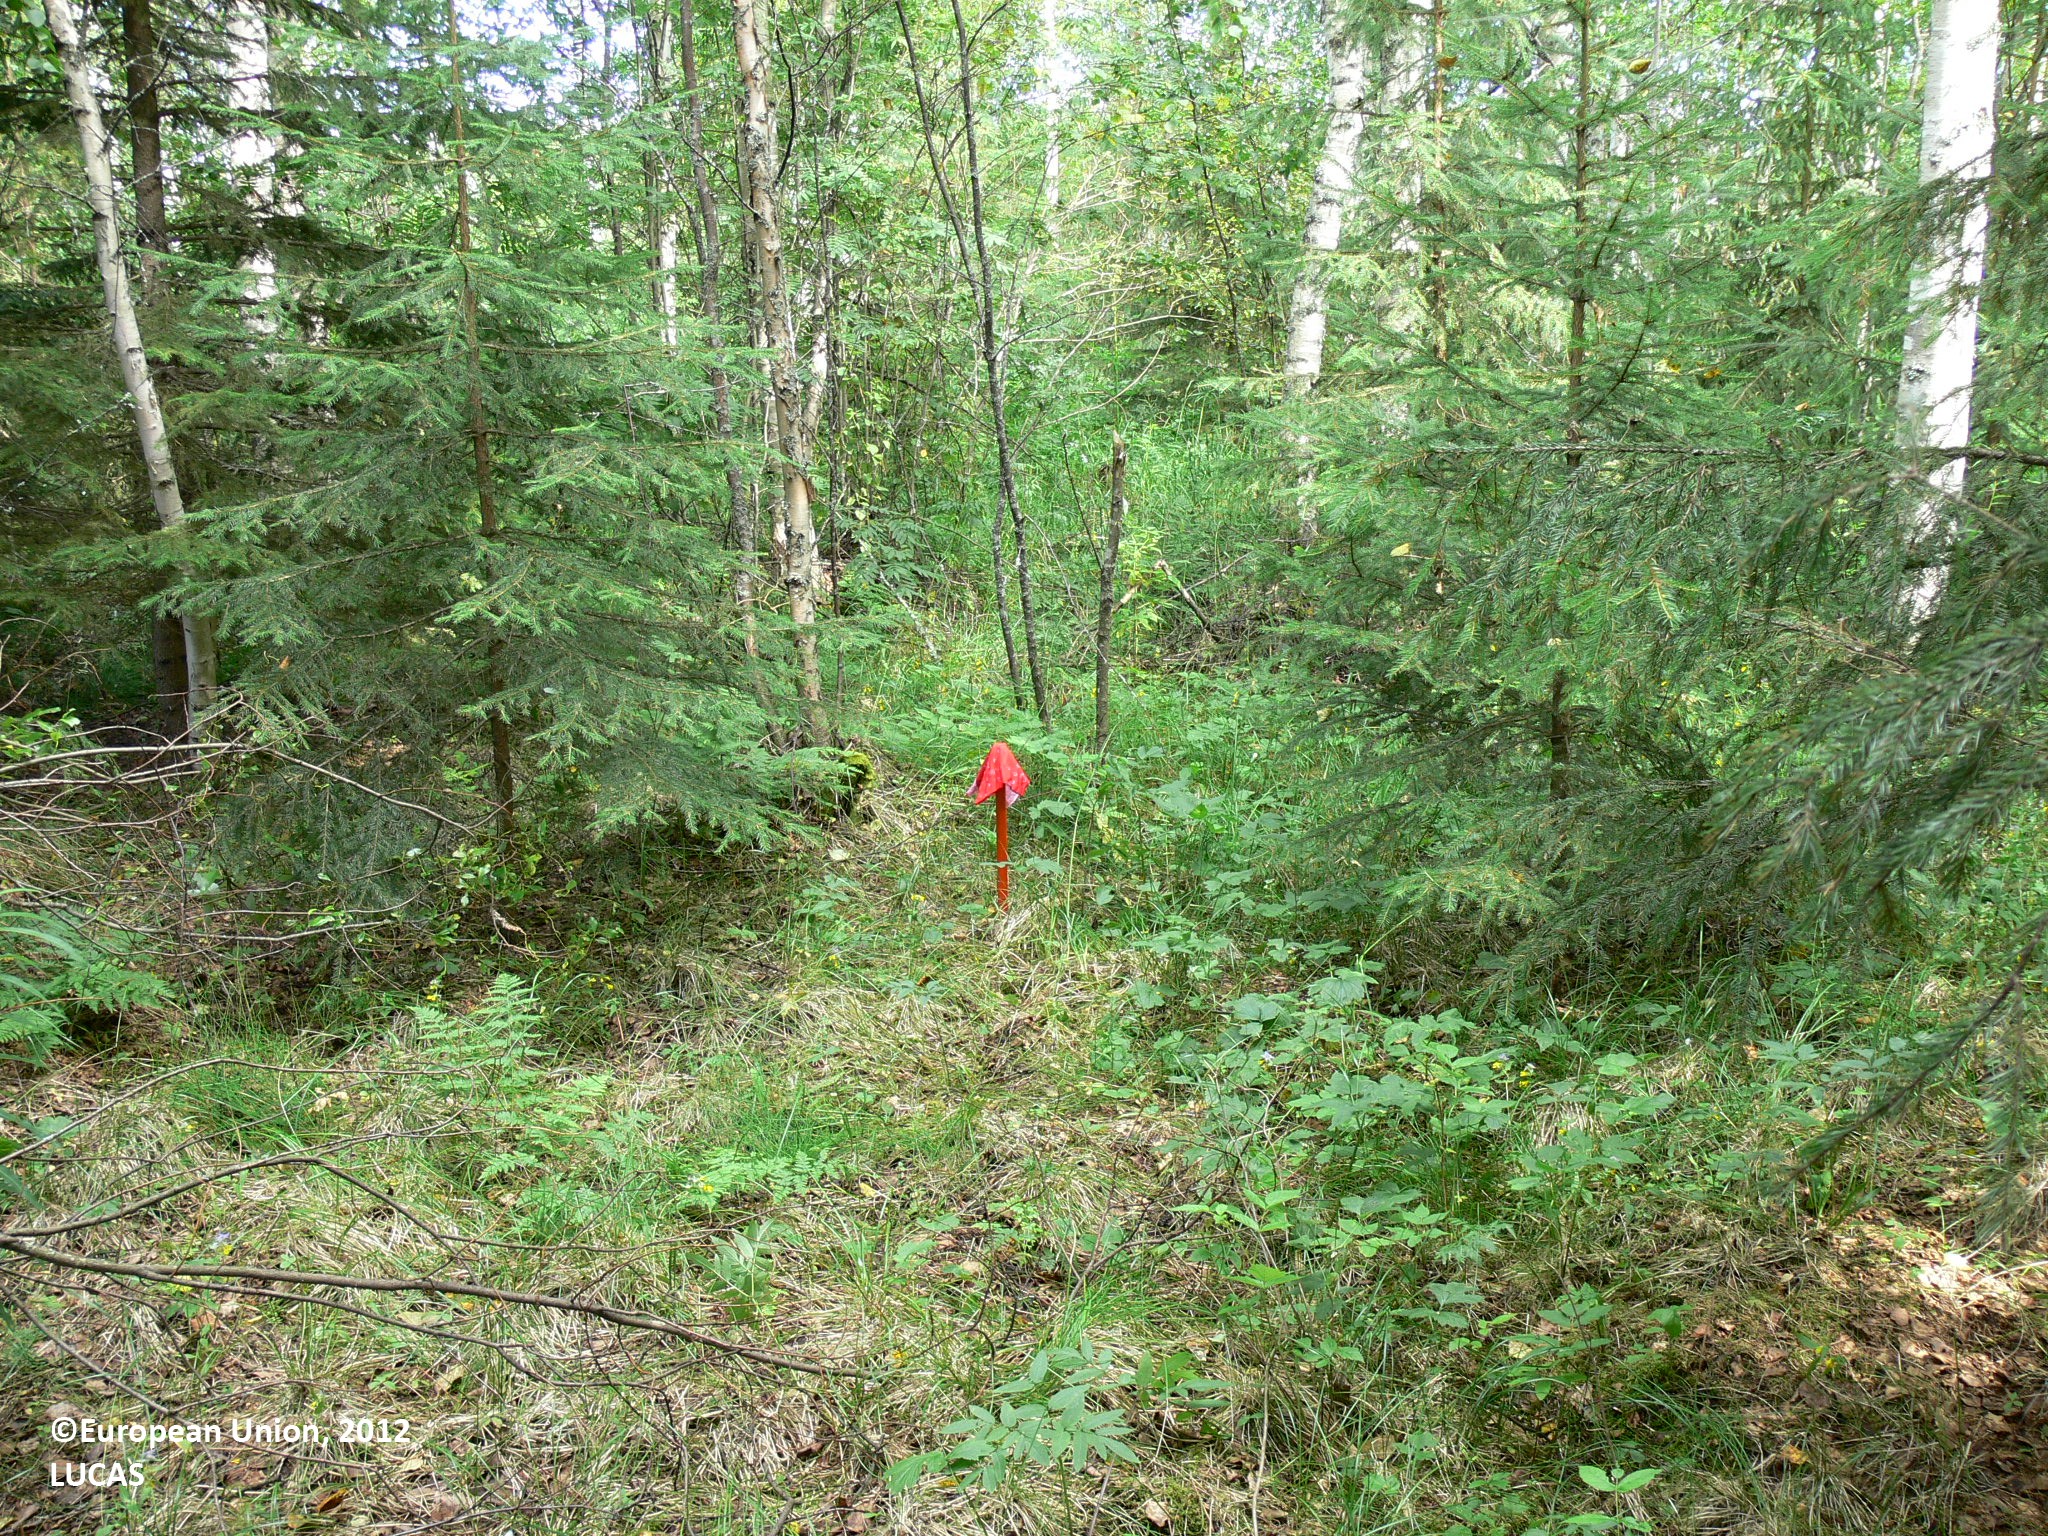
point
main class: Woodland
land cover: Spruce dominated mixed woodland
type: boreal forest
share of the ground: > 75 %
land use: Forestry
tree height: > 5 m
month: July
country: FI
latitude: 62.0260
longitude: 30.0469
